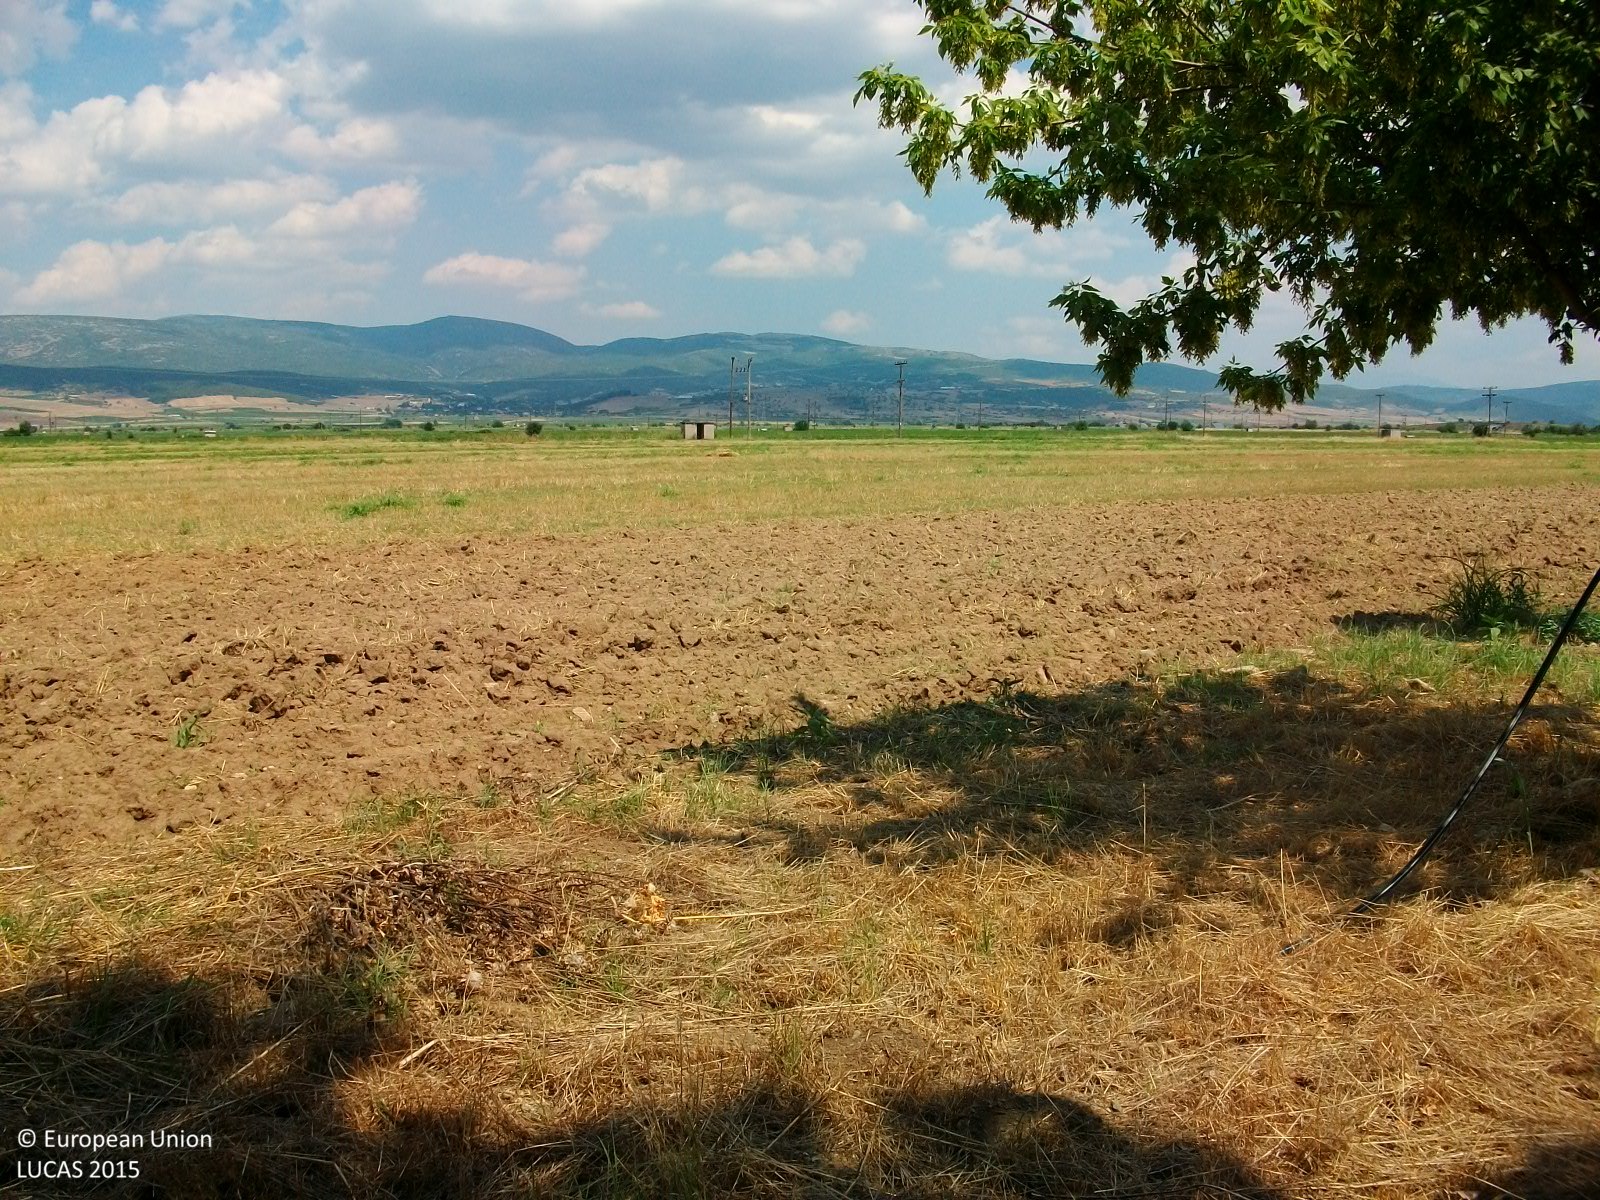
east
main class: Grassland
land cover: Grassland with sparse tree/shrub cover
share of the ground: > 75 %
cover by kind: herbaceous plants 90 %, broadleaved forest trees 5 %, unconsolidated bare surface 5 %
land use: Community services
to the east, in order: Grassland with sparse tree/shrub cover; Other bare soil; Common wheat; Cotton
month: July
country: GR
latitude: 39.2016
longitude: 22.2691
